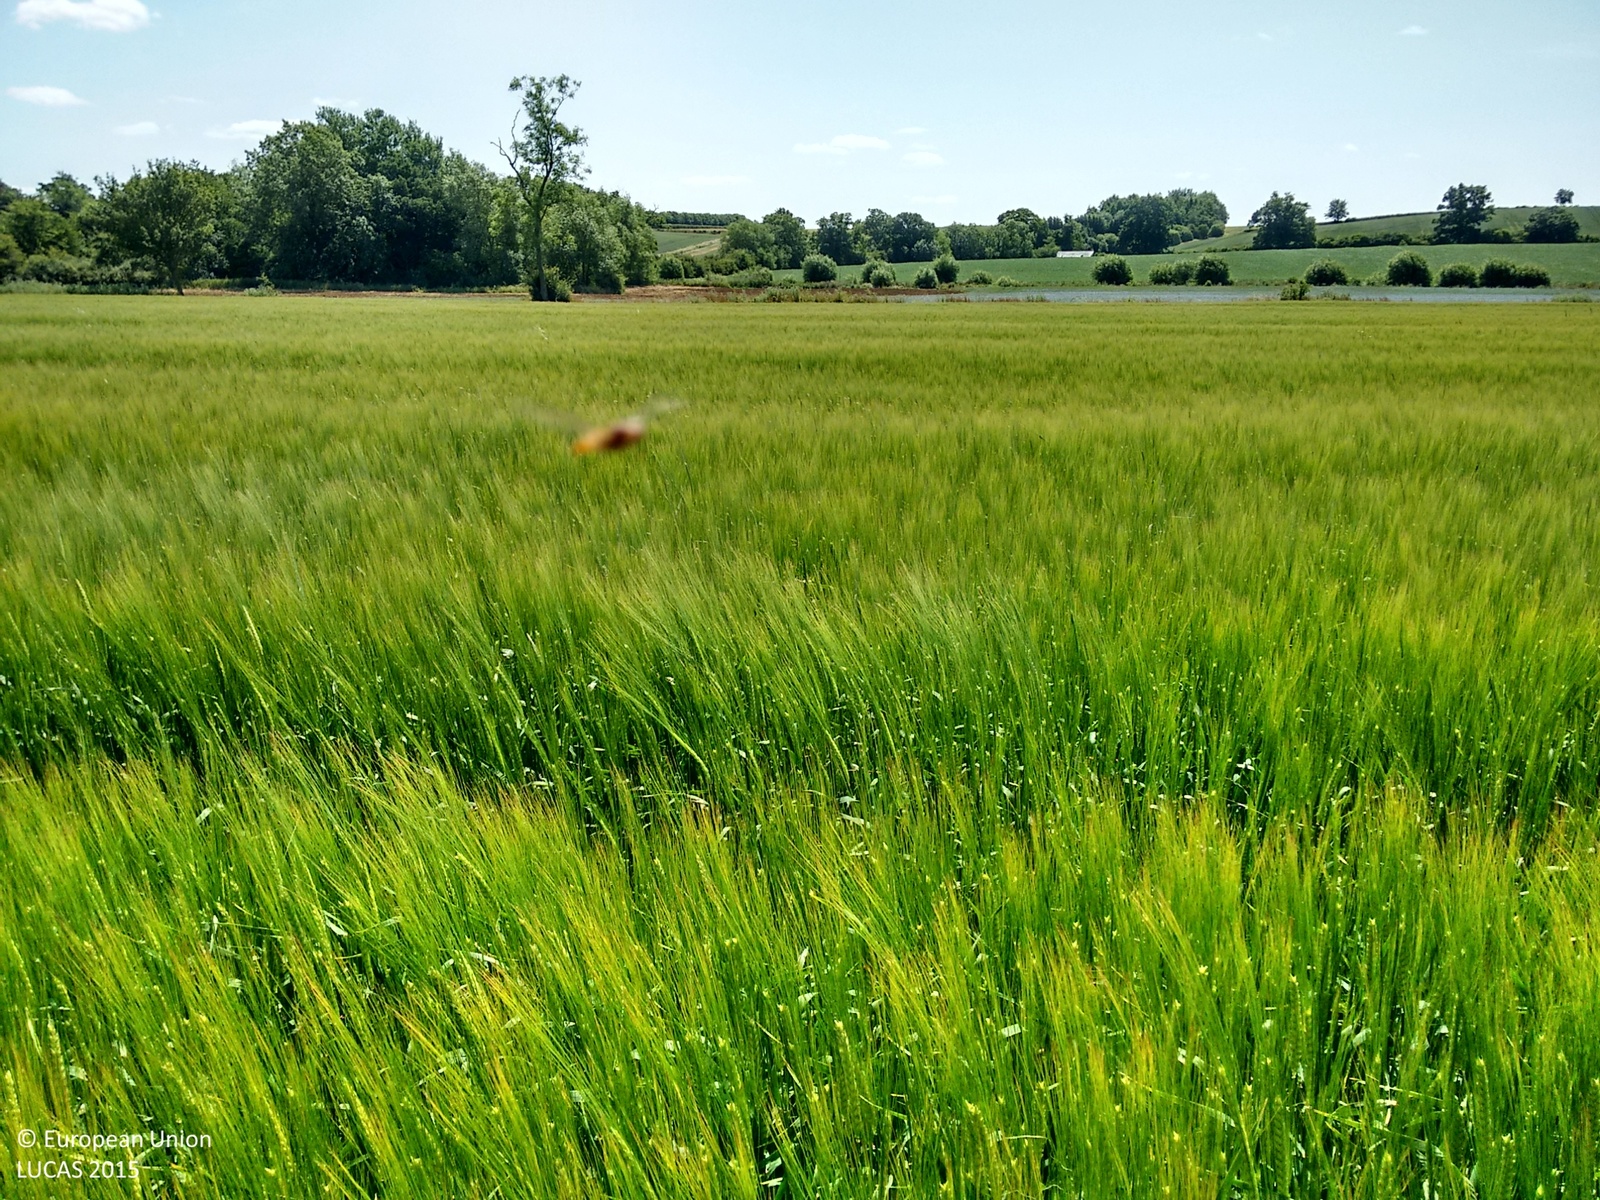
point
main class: Cropland
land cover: Barley
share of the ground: > 75 %
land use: Agriculture (excluding fallow land and kitchen gardens)
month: July
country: GB
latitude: 51.9987
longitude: -1.3075
